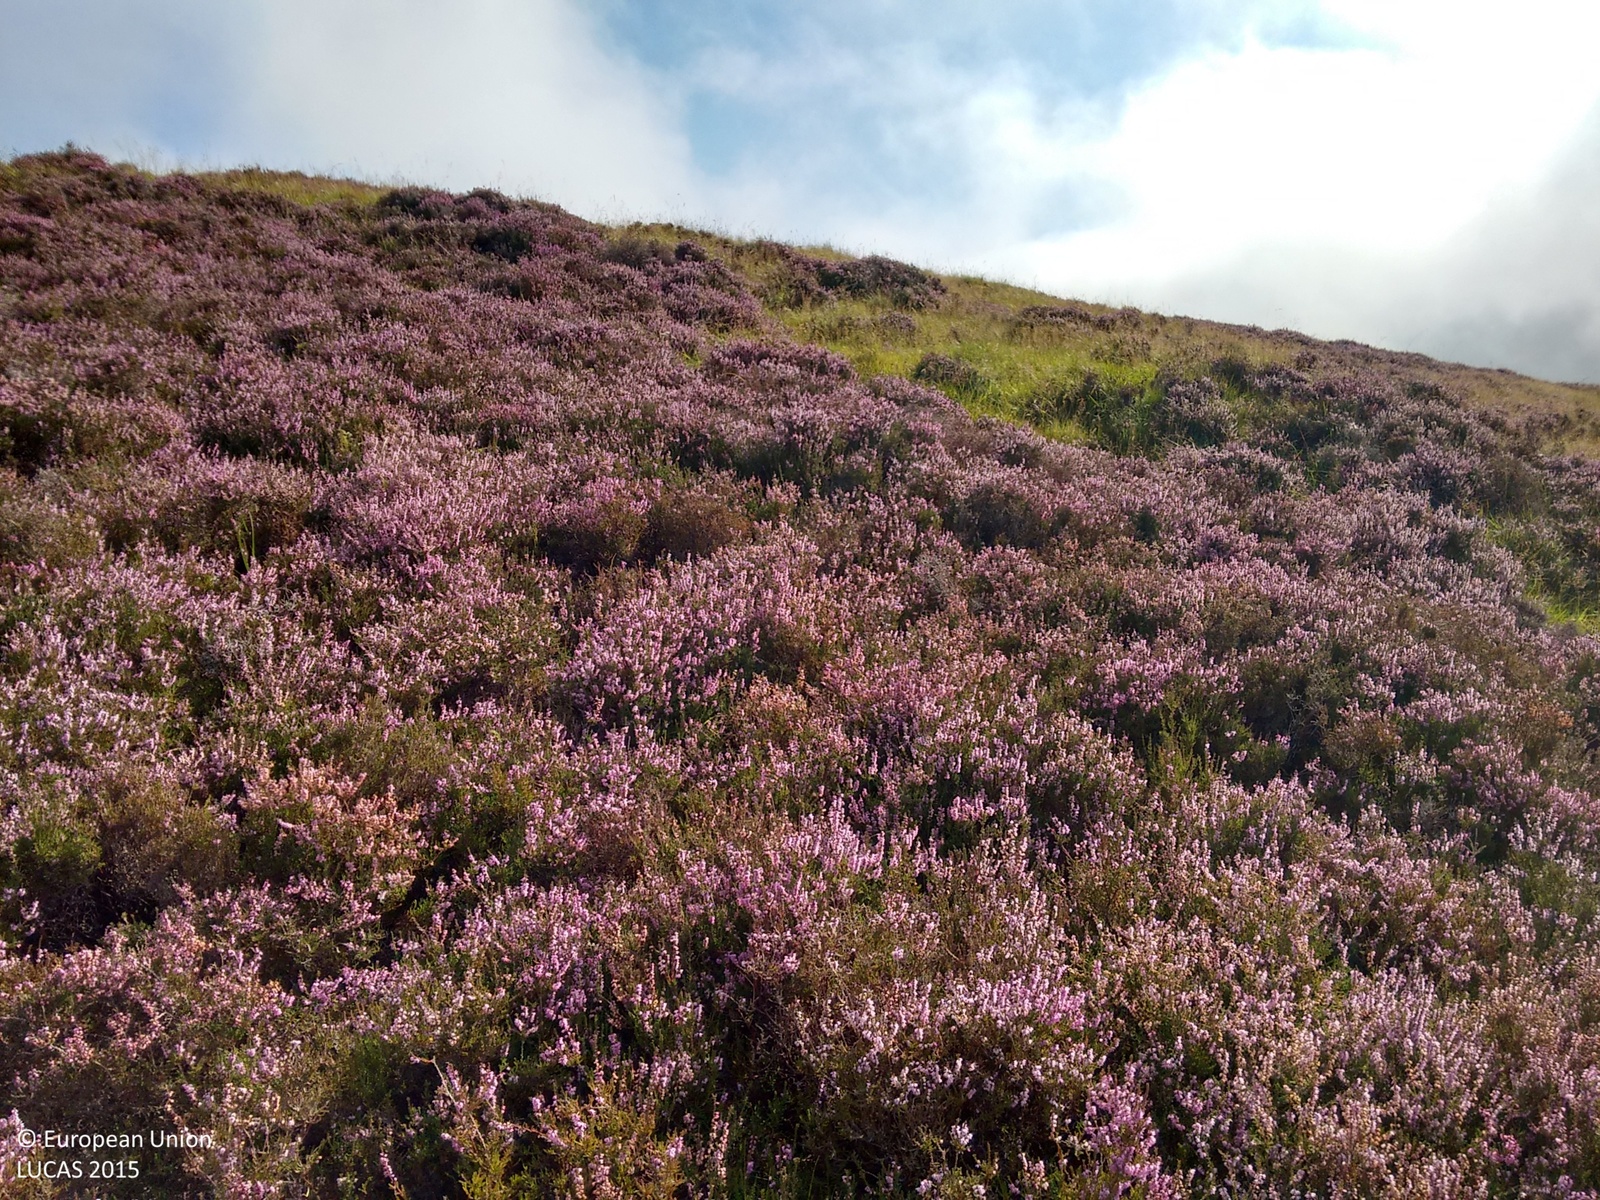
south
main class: Shrubland
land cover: Shrubland without tree cover
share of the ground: > 75 %
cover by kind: shrubs 100 %
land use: Agriculture (excluding fallow land and kitchen gardens)
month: September
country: GB
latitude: 58.0363
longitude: -4.1200
